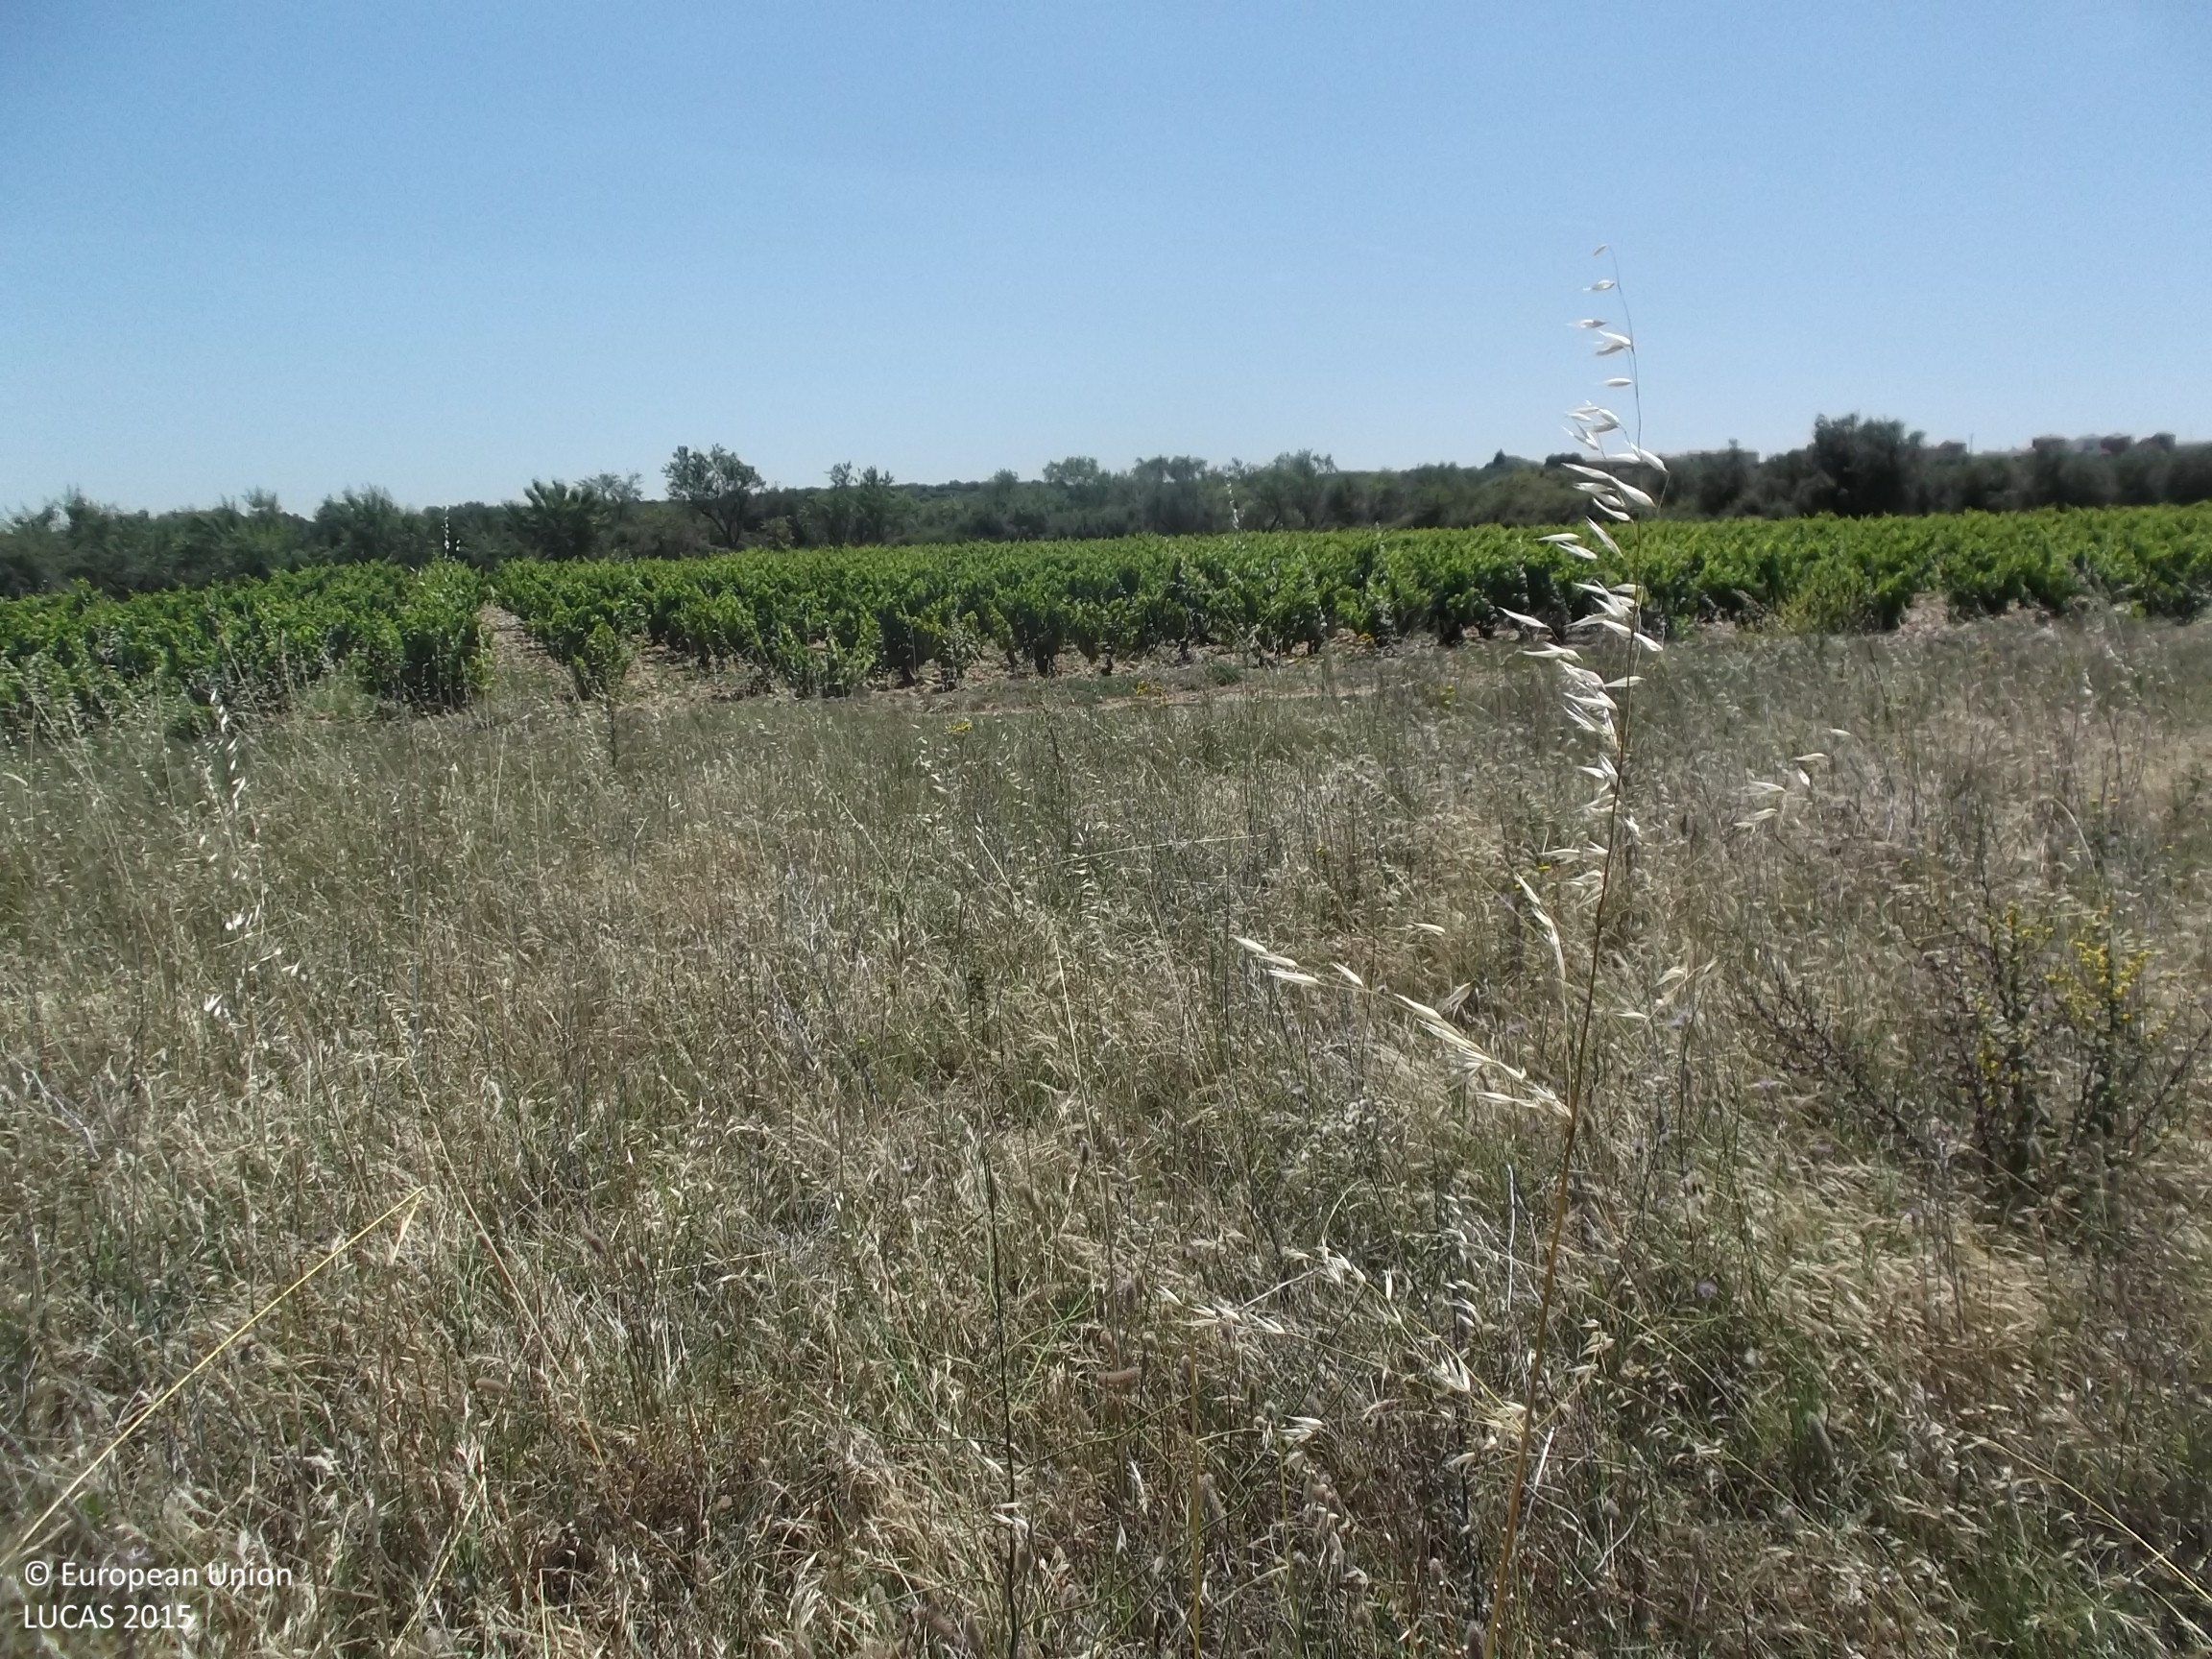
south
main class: Grassland
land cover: Spontaneously vegetated surfaces
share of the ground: > 75 %
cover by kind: herbaceous plants 90 %, unconsolidated bare surface 5 %
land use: Fallow land
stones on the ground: < 10 %
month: June
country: ES
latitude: 42.3076
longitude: -2.1101
